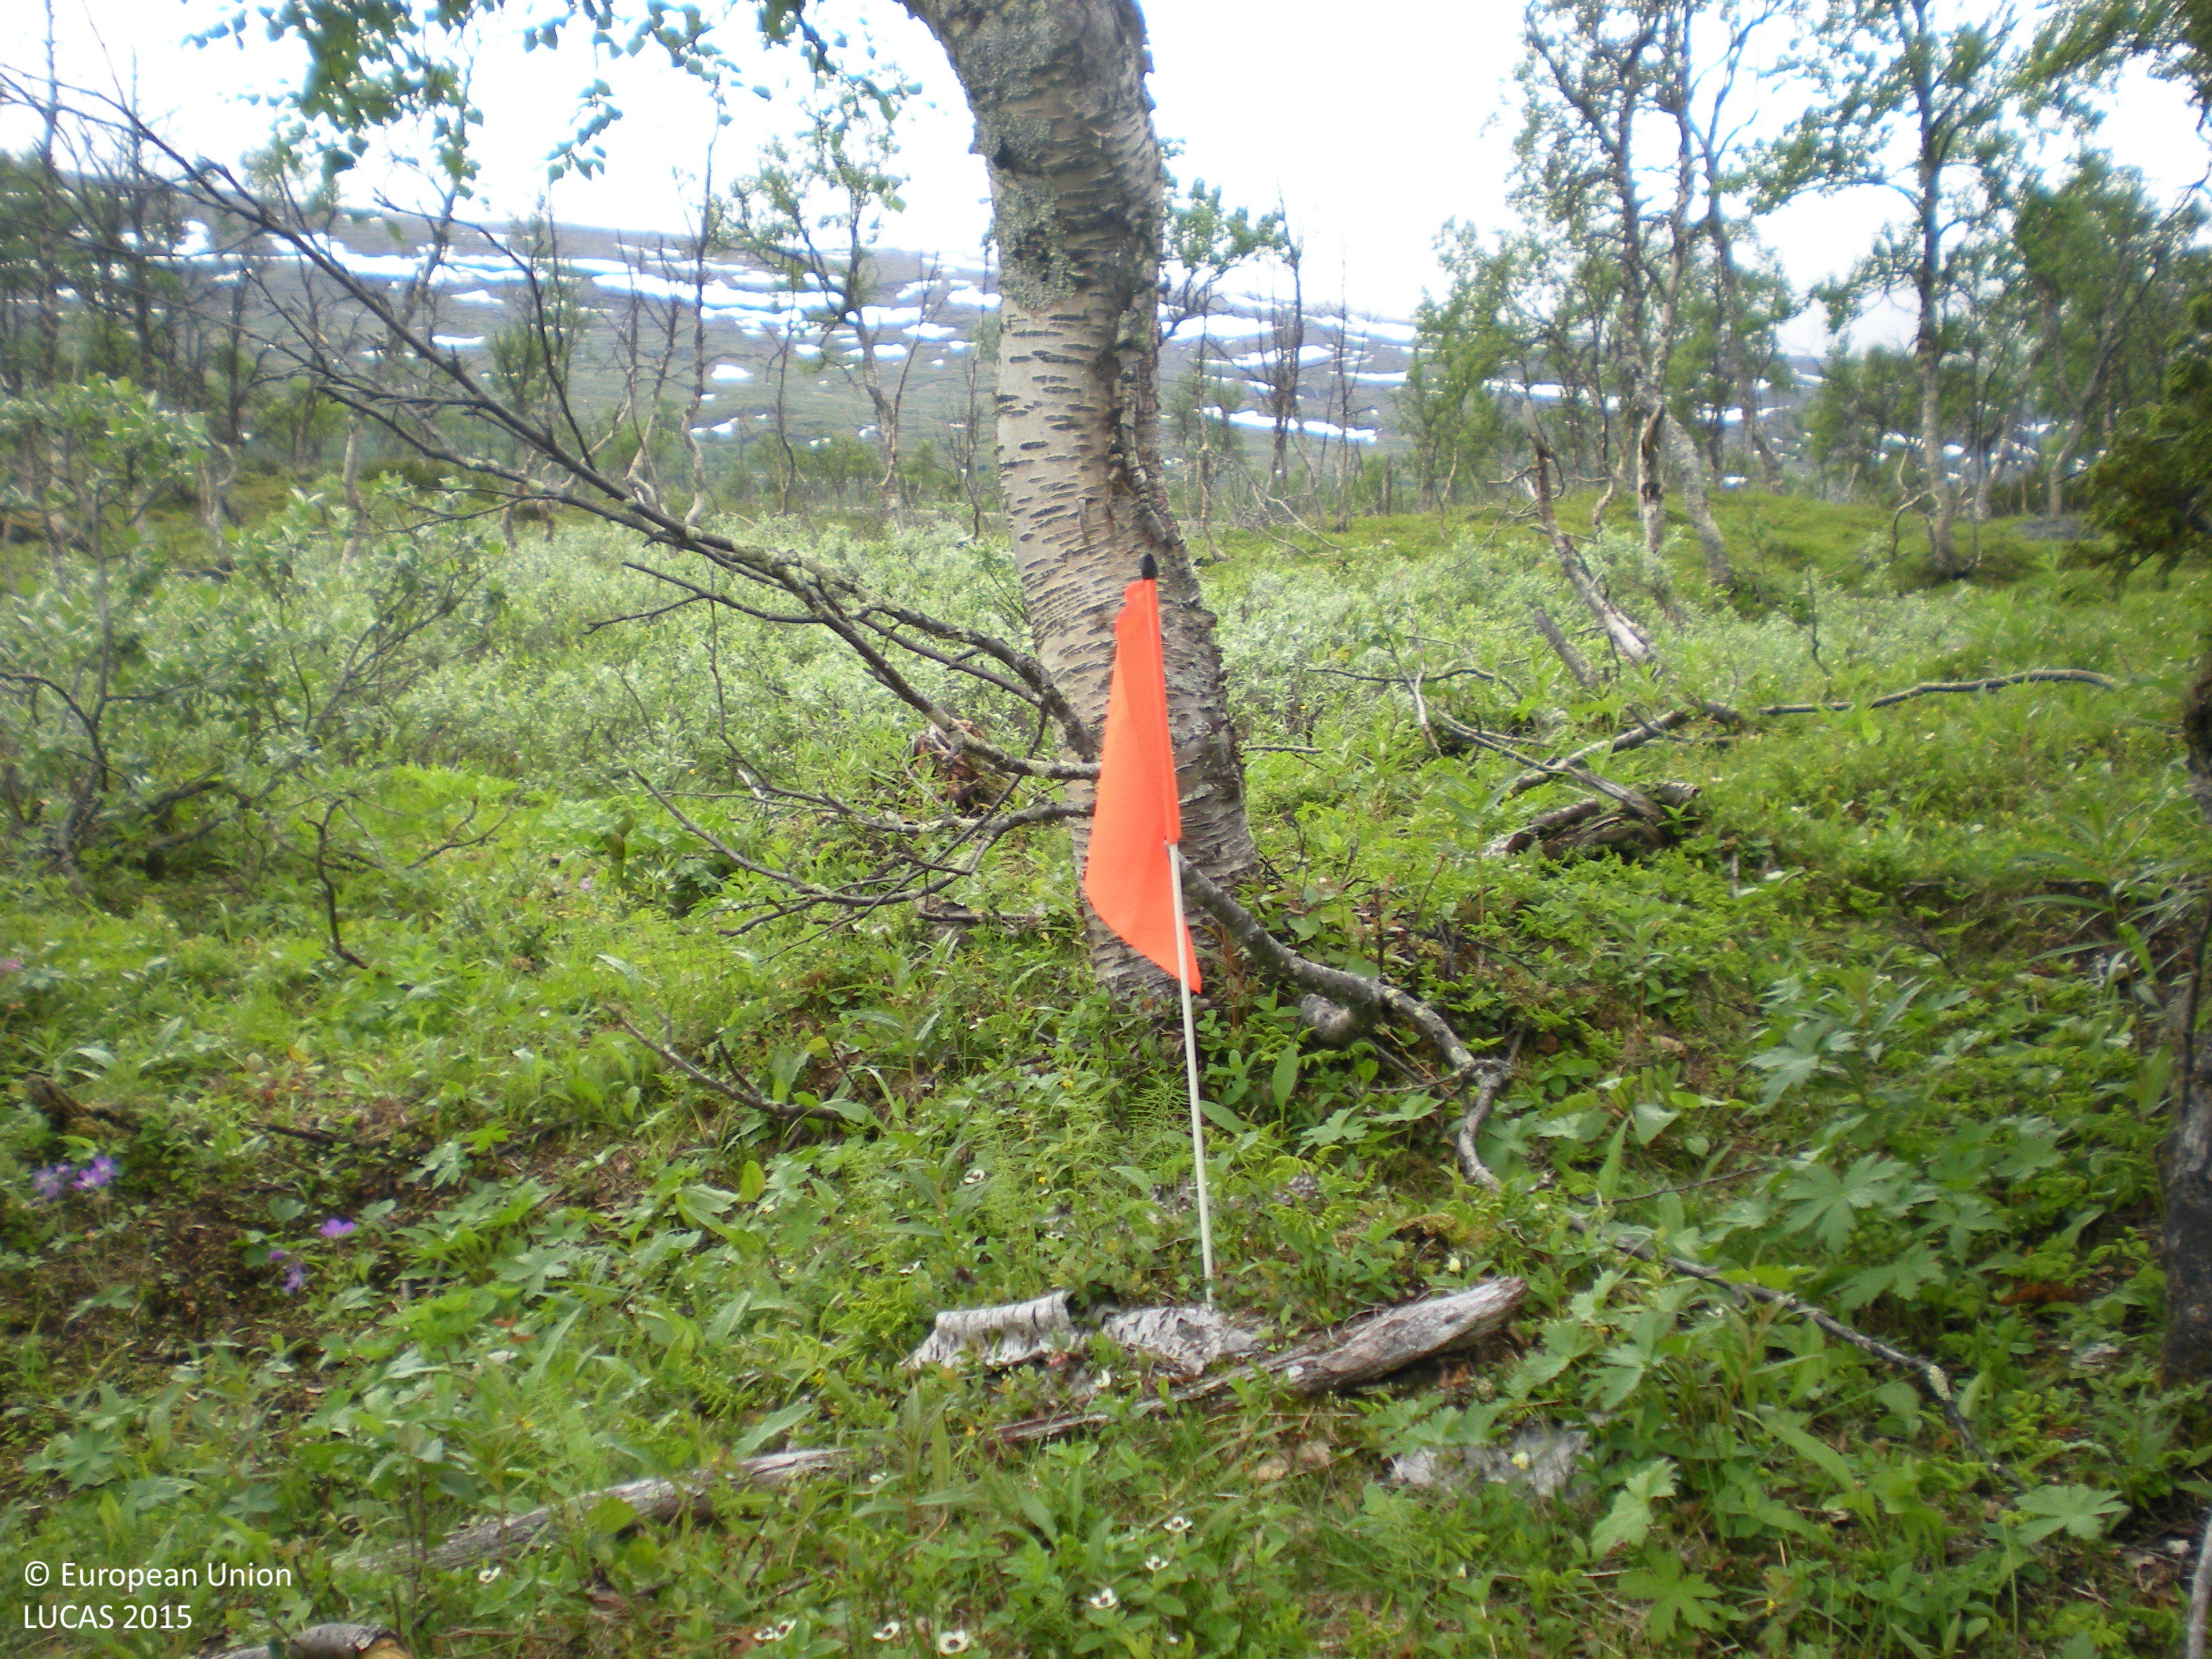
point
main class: Woodland
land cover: Broadleaved woodland
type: boreal forest
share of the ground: 25 - 50 %
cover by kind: broadleaved forest trees 50 %, herbaceous plants 30 %, shrubs 20 %
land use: Semi-natural and natural areas not in use
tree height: < 5 m
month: August
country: SE
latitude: 66.6933
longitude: 16.0928
